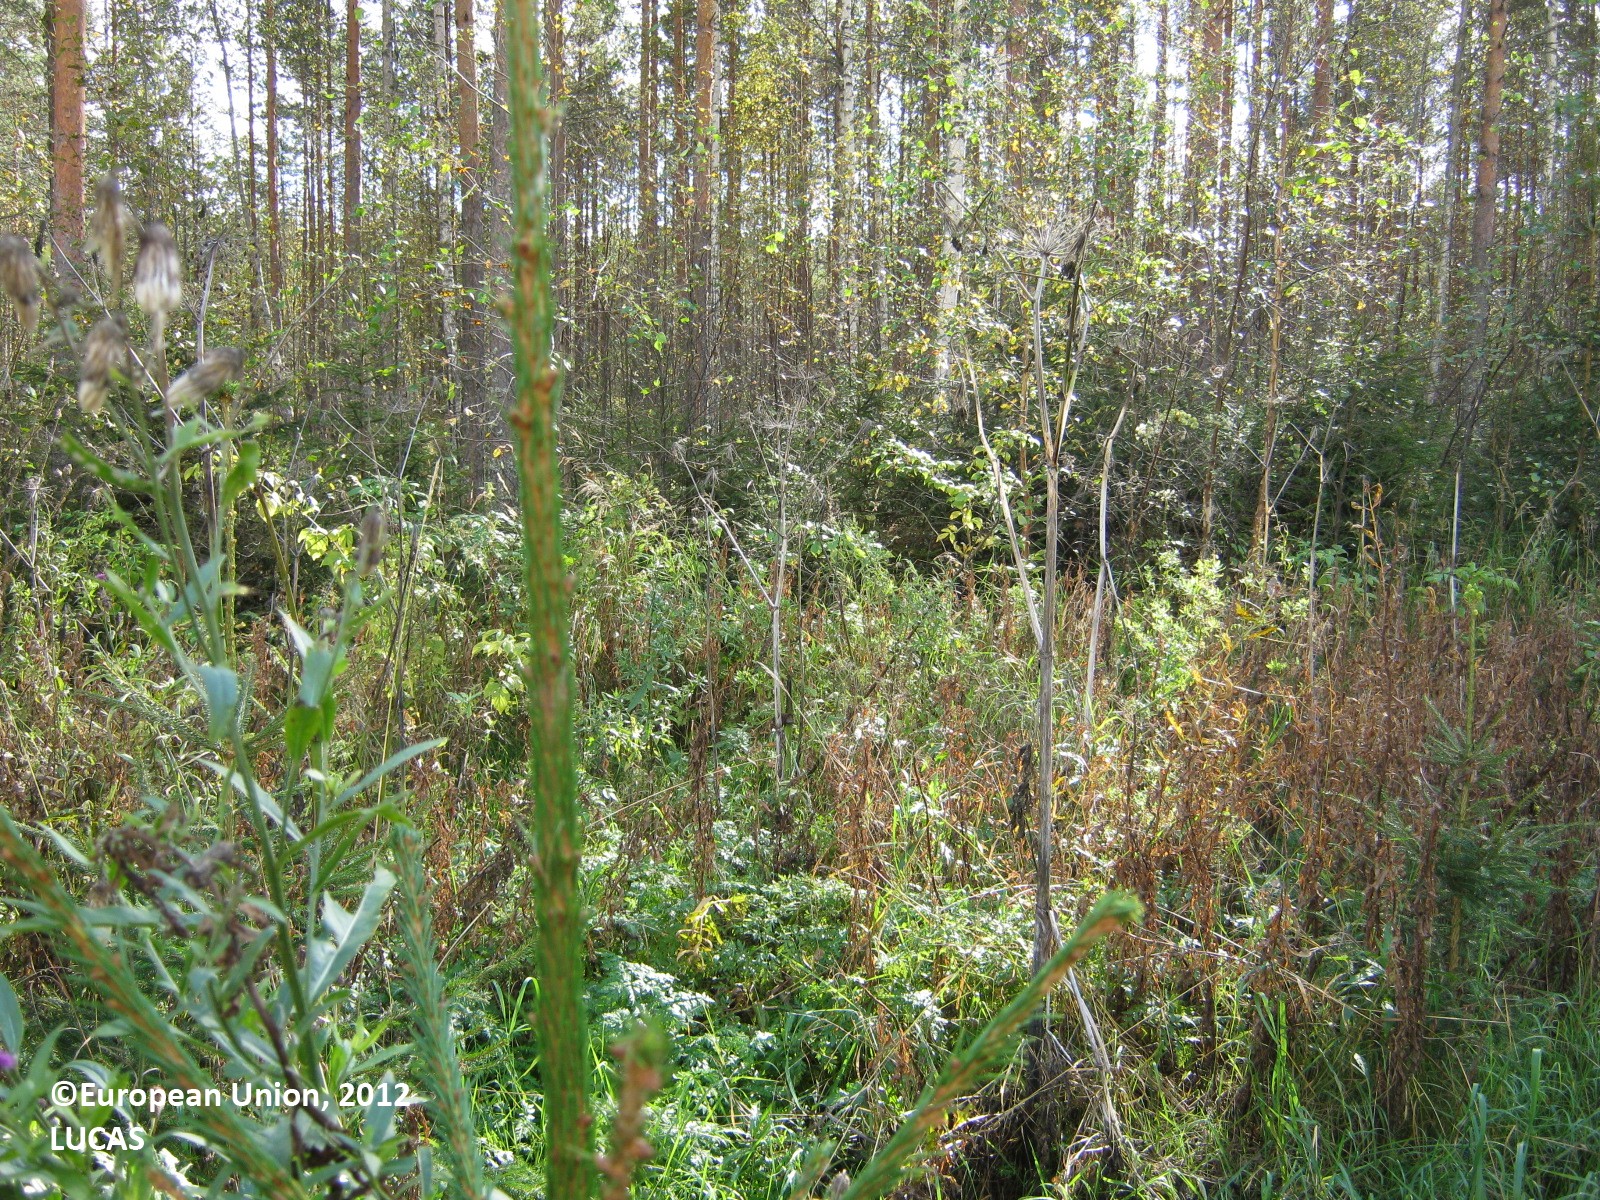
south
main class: Shrubland
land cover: Shrubland with sparse tree cover
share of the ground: > 75 %
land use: Semi-natural and natural areas not in use
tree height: < 5 m
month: September
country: FI
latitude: 60.8932
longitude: 27.7544
